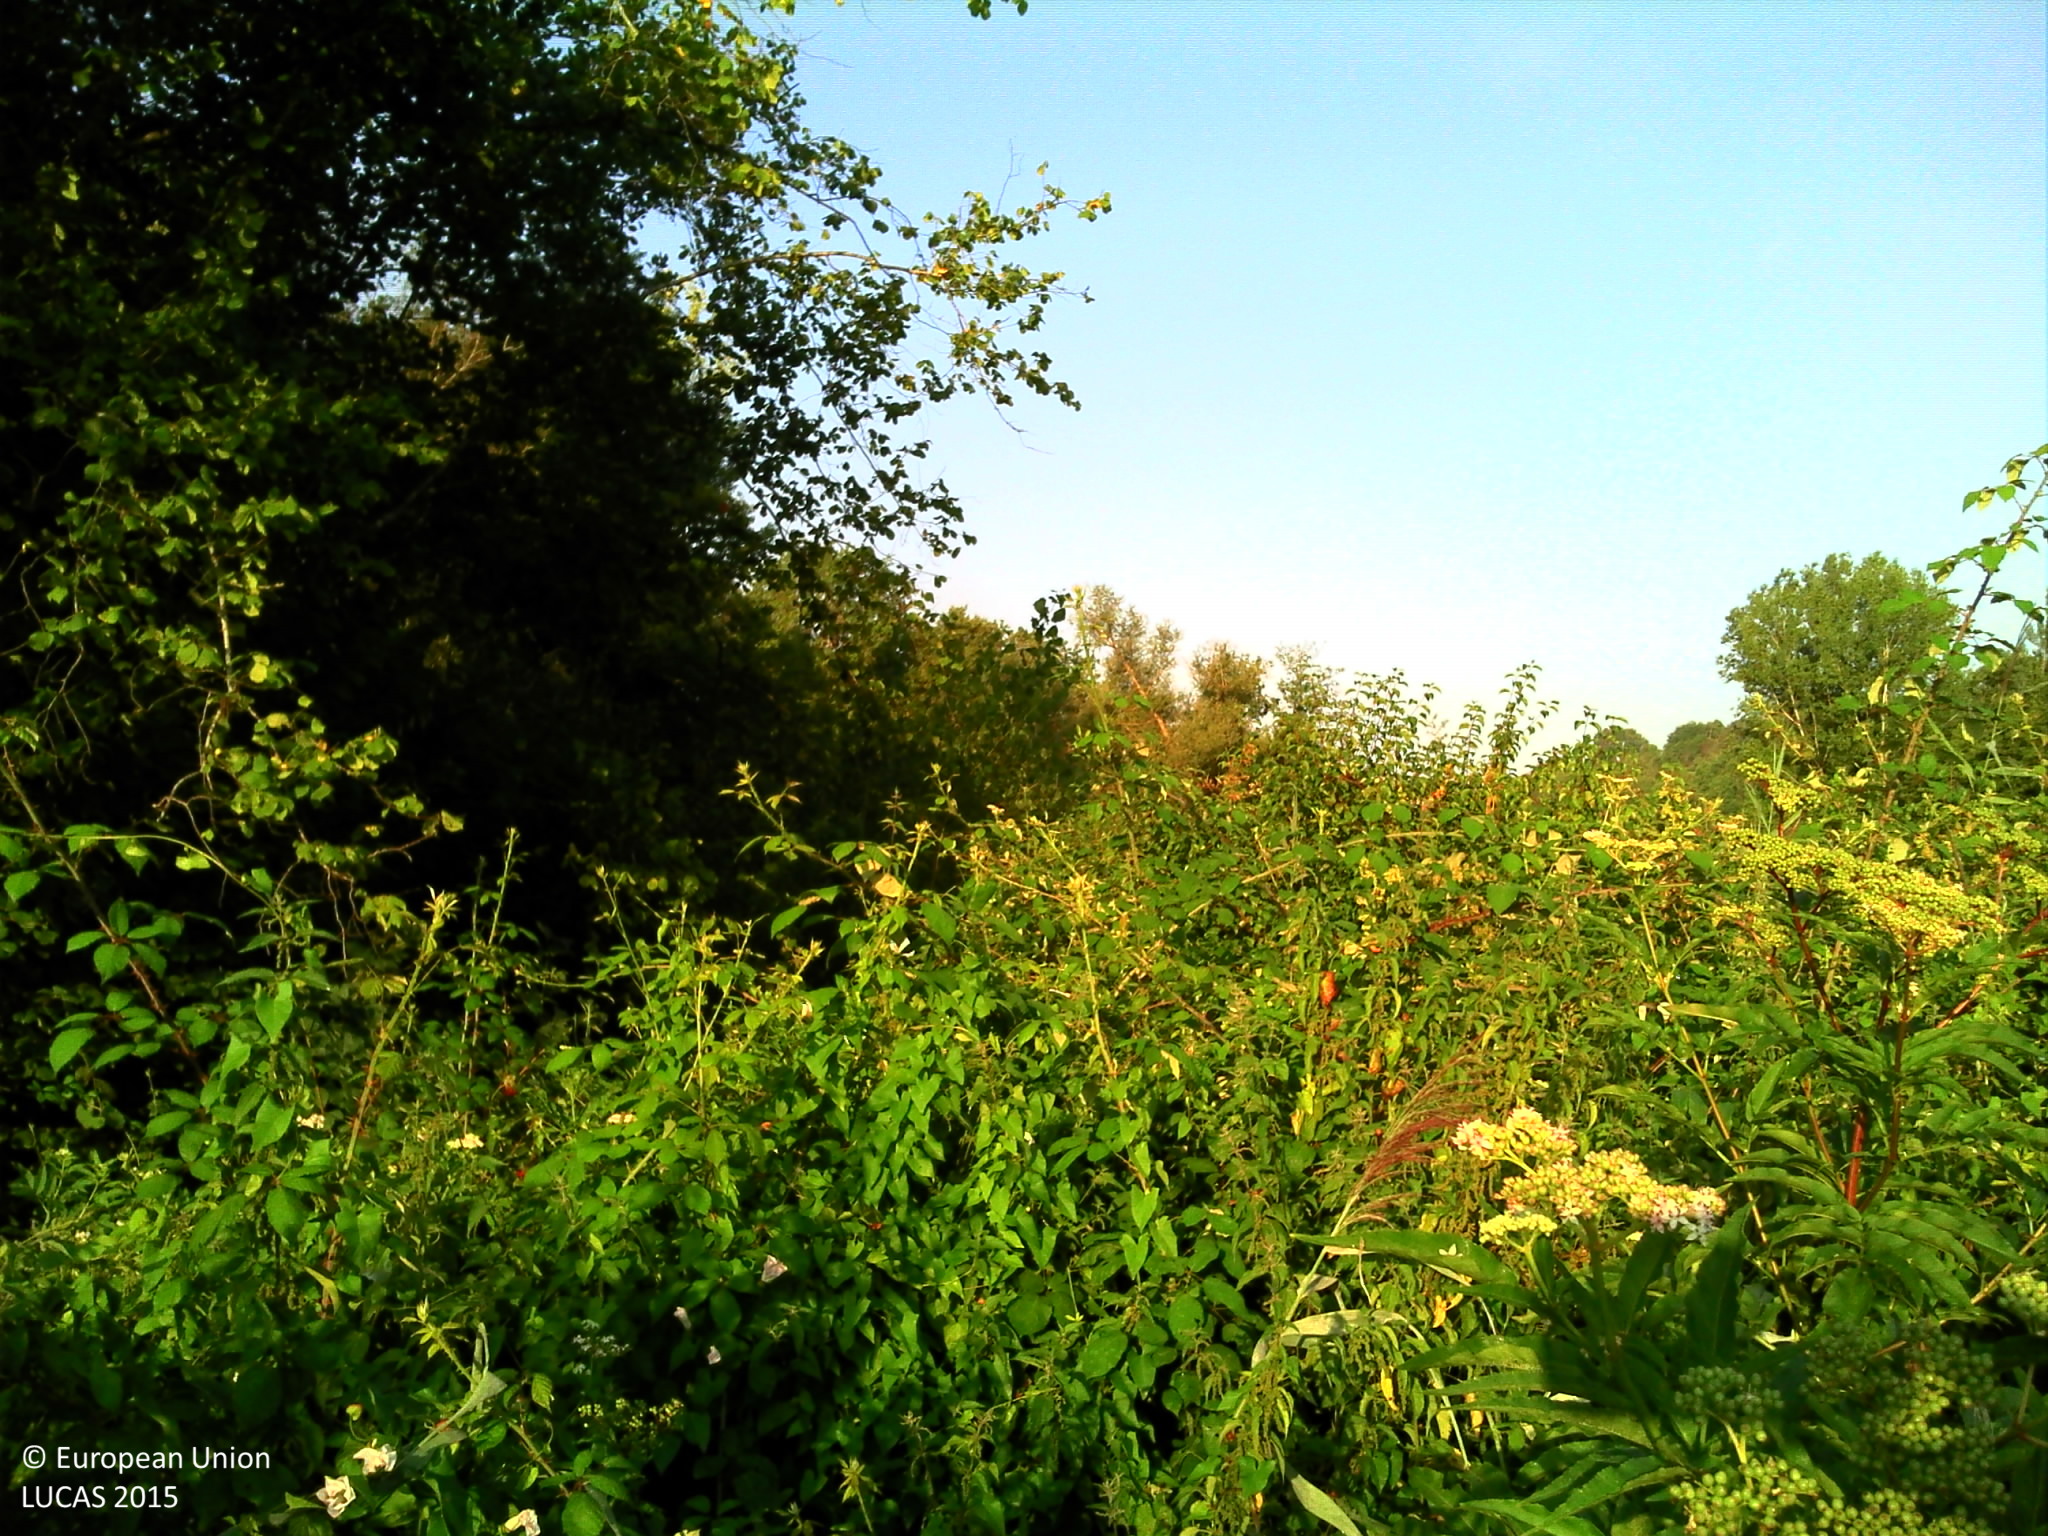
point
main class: Woodland
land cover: Broadleaved woodland
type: thermophilous deciduous forest
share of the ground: > 75 %
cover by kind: broadleaved forest trees 80 %, herbaceous plants 20 %
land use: Forestry
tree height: > 5 m
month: August
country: FR
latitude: 44.8250
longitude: 0.9505
